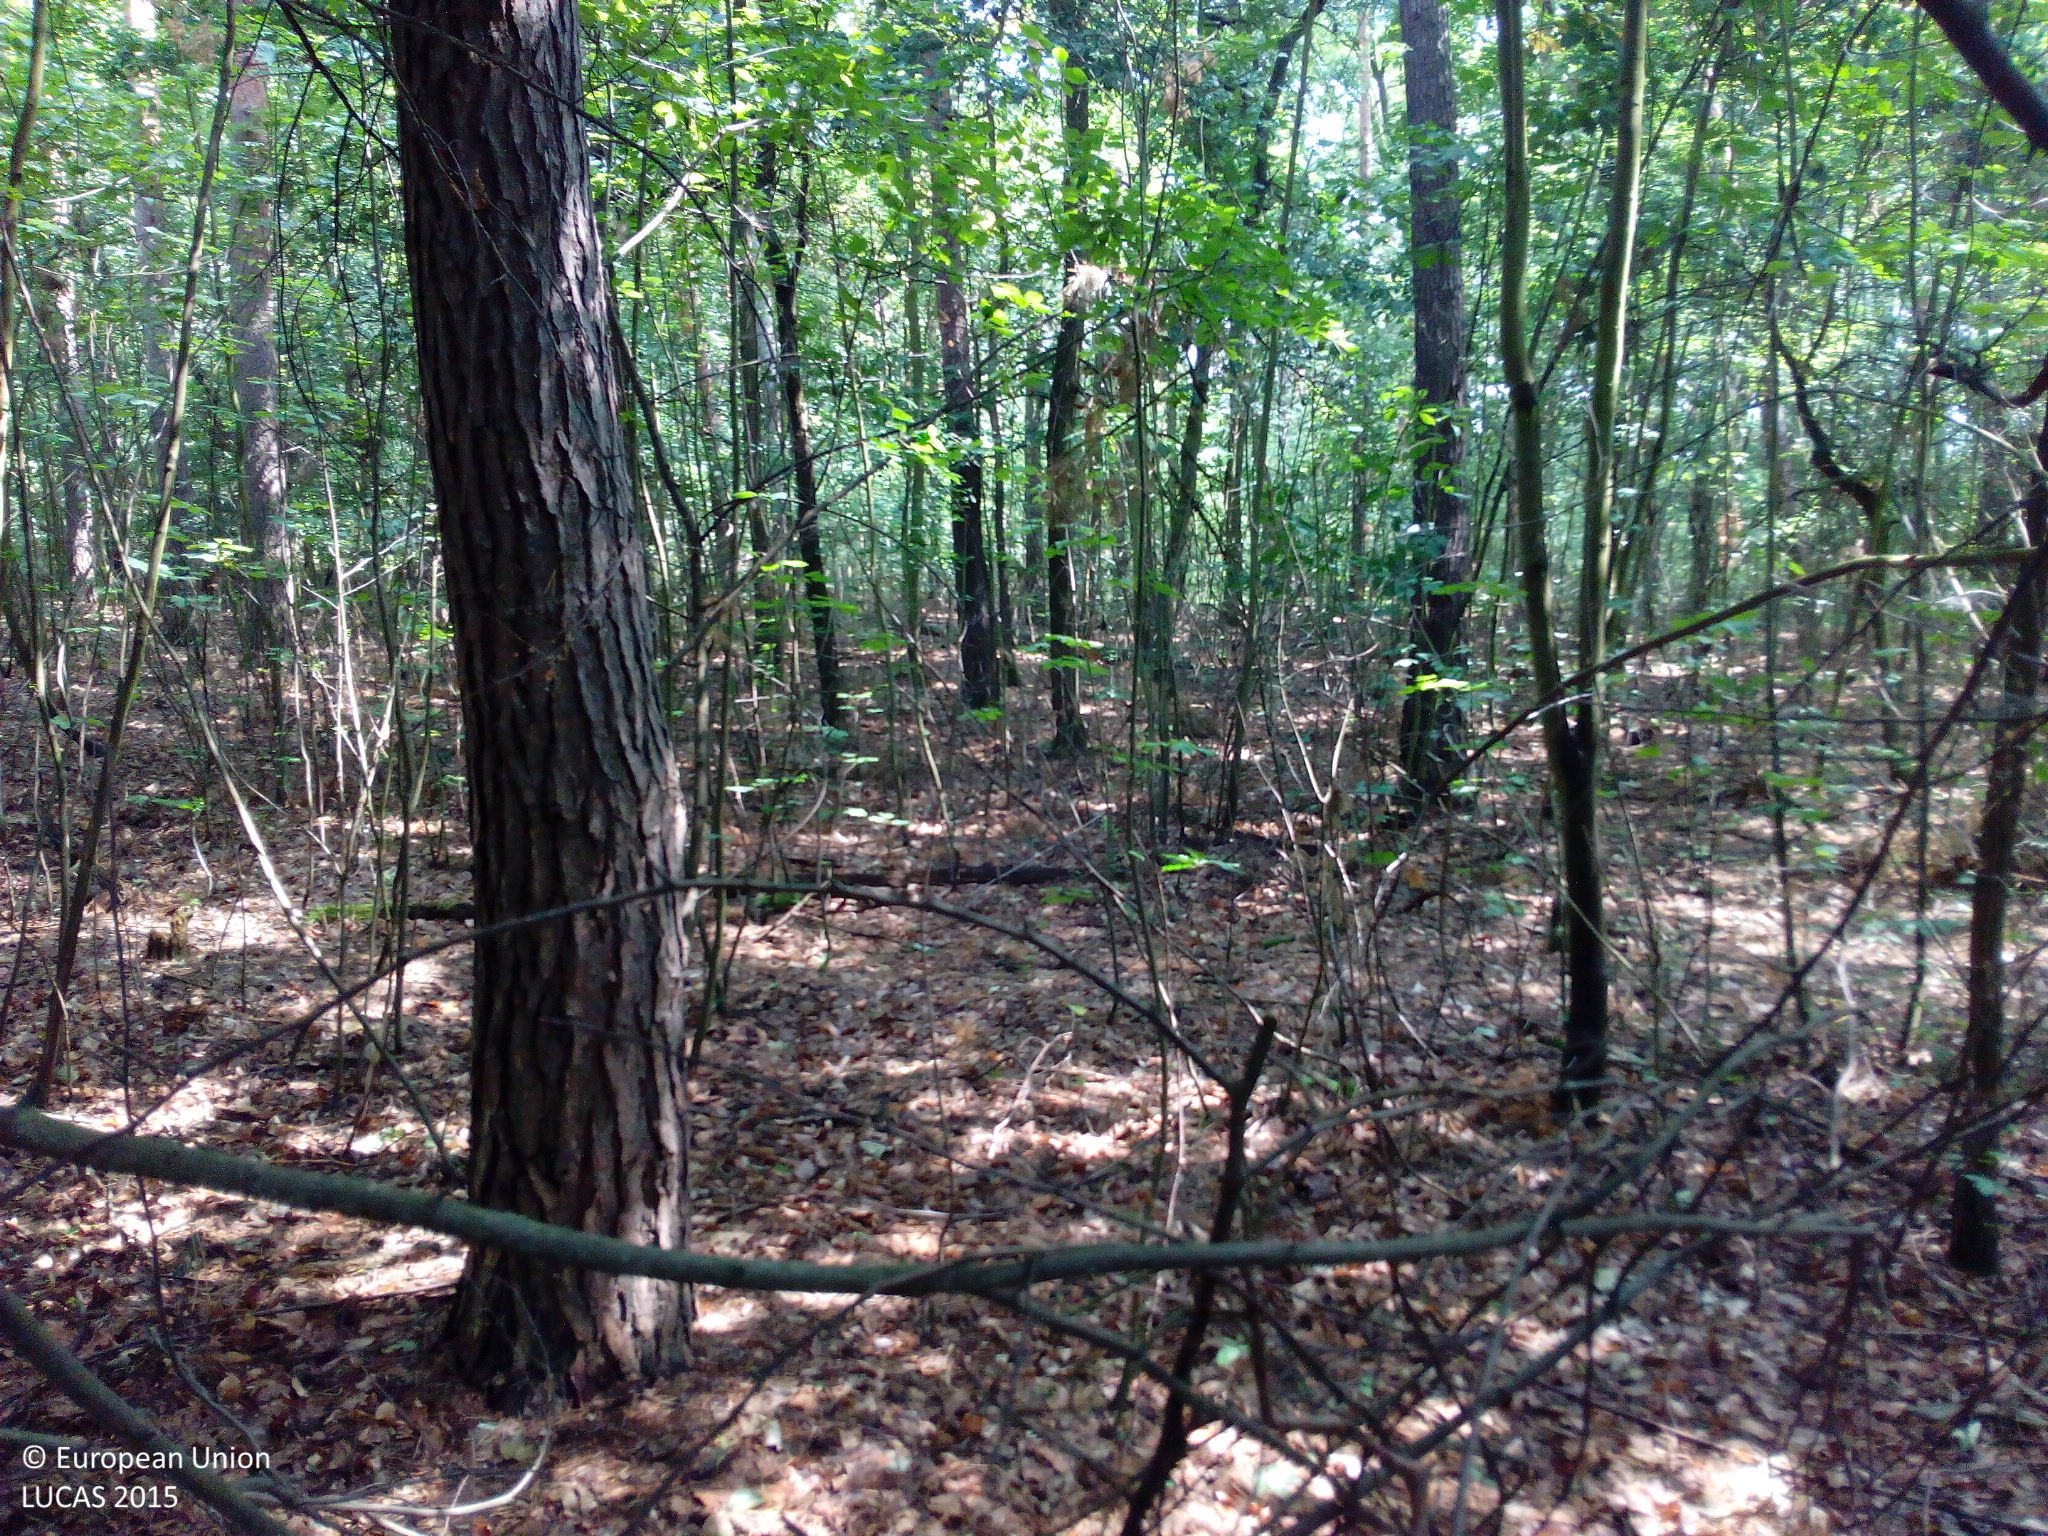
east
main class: Woodland
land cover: Pine dominated mixed woodland
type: hemiboreal forest and nemoral coniferous forest and mixed broadleaved-coniferous forest
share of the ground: > 75 %
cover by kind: coniferous forest trees 70 %, broadleaved forest trees 30 %
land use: Forestry
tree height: > 5 m
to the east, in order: Pine dominated mixed woodland; Tracks; Pine dominated coniferous woodland; Tracks; Pine dominated mixed woodland; Tracks; Pine dominated mixed woodland
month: July
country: DE
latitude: 52.4605
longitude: 13.1937
